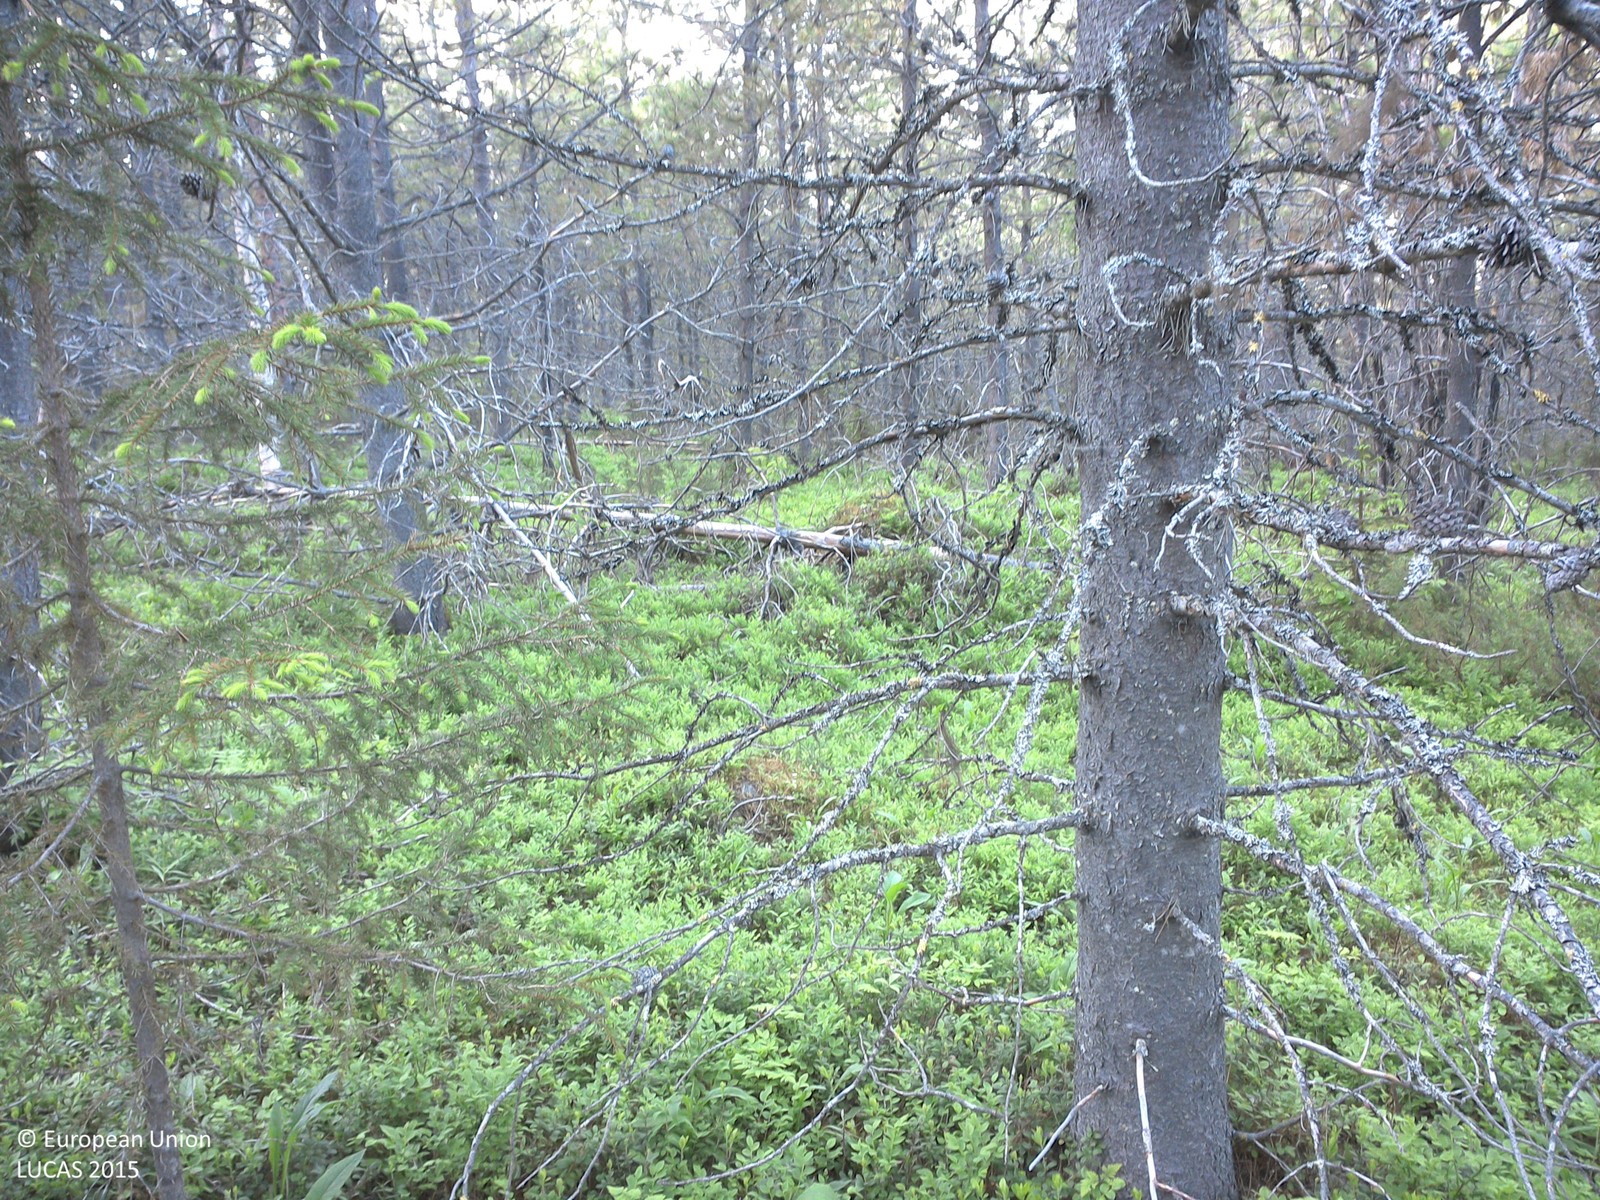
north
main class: Woodland
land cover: Pine dominated coniferous woodland
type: exotic forest
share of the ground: 25 - 50 %
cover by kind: shrubs 60 %, coniferous forest trees 40 %
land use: Forestry
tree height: > 5 m
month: June
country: SE
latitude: 66.5997
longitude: 22.9956
